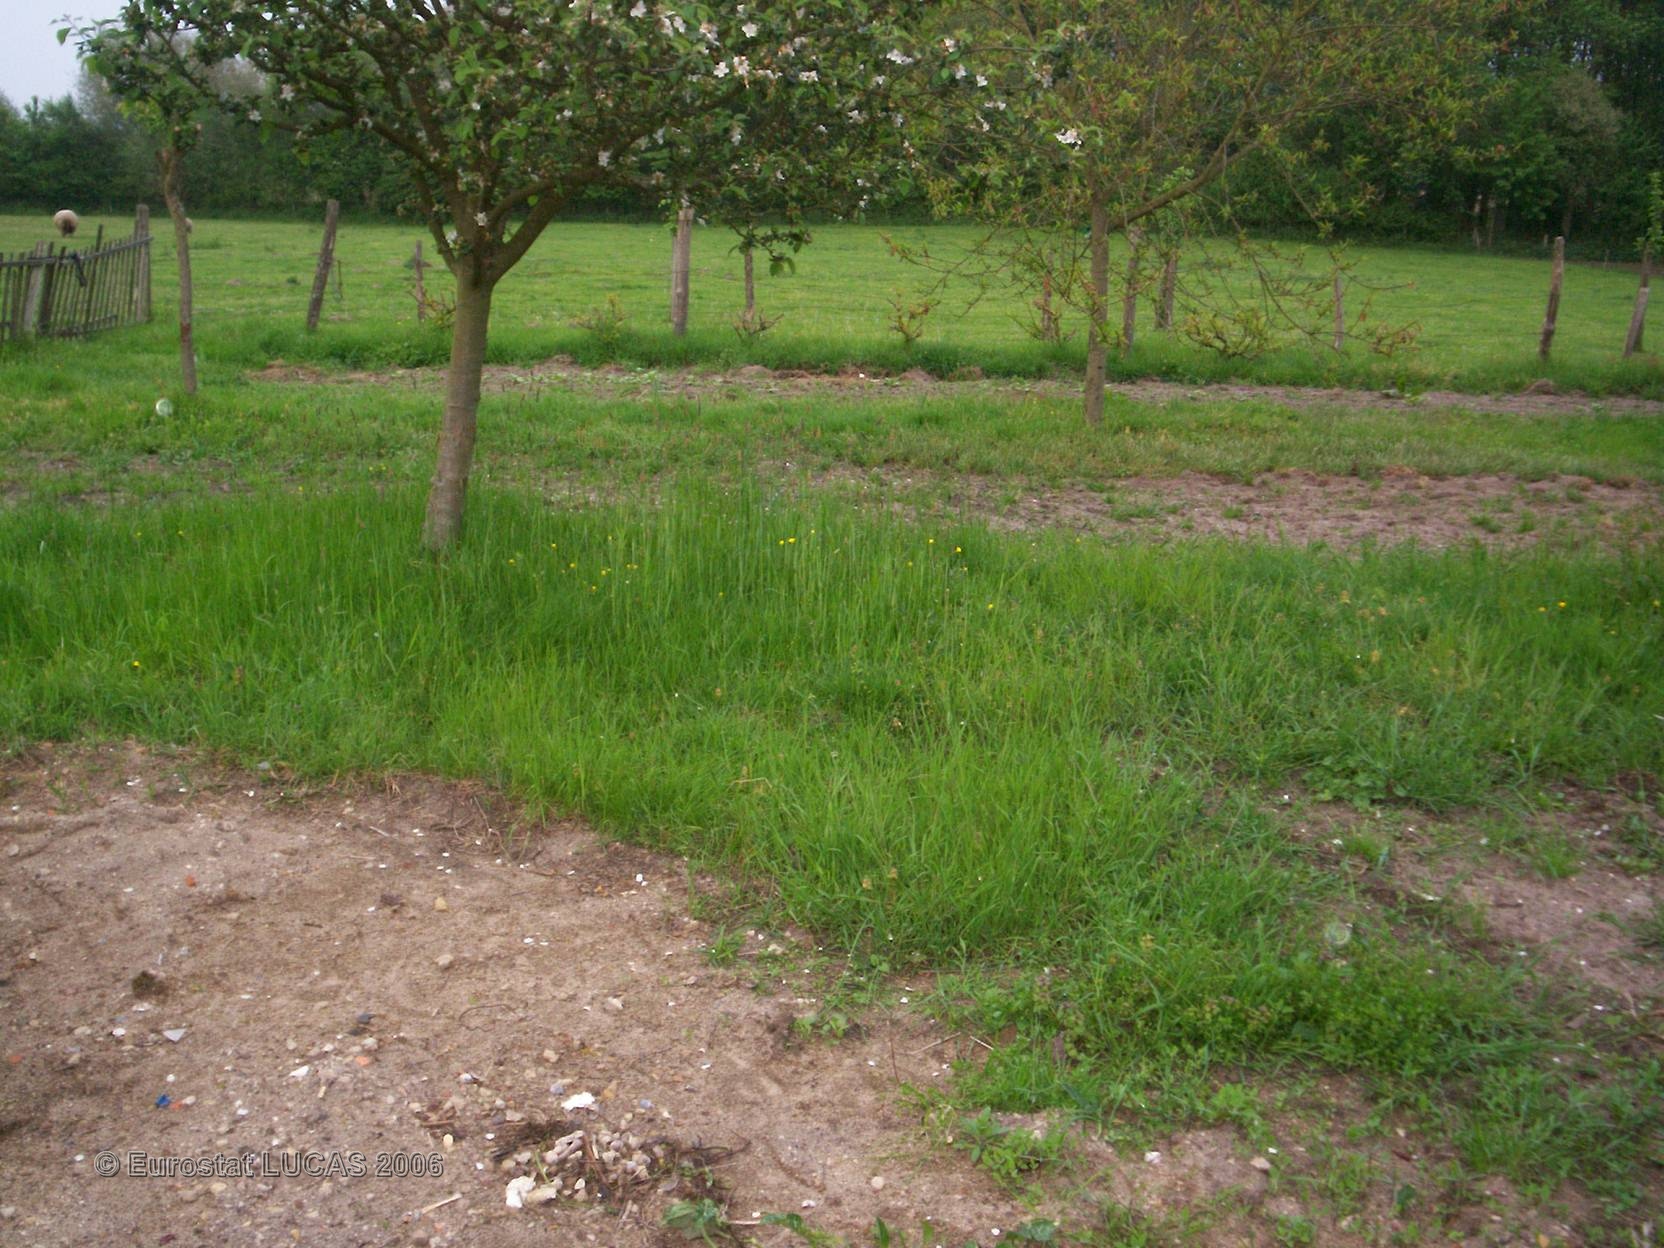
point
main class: Grassland
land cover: Grassland with sparse tree/shrub cover
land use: Residential
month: May
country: FR
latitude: 47.8766
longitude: 0.2004
